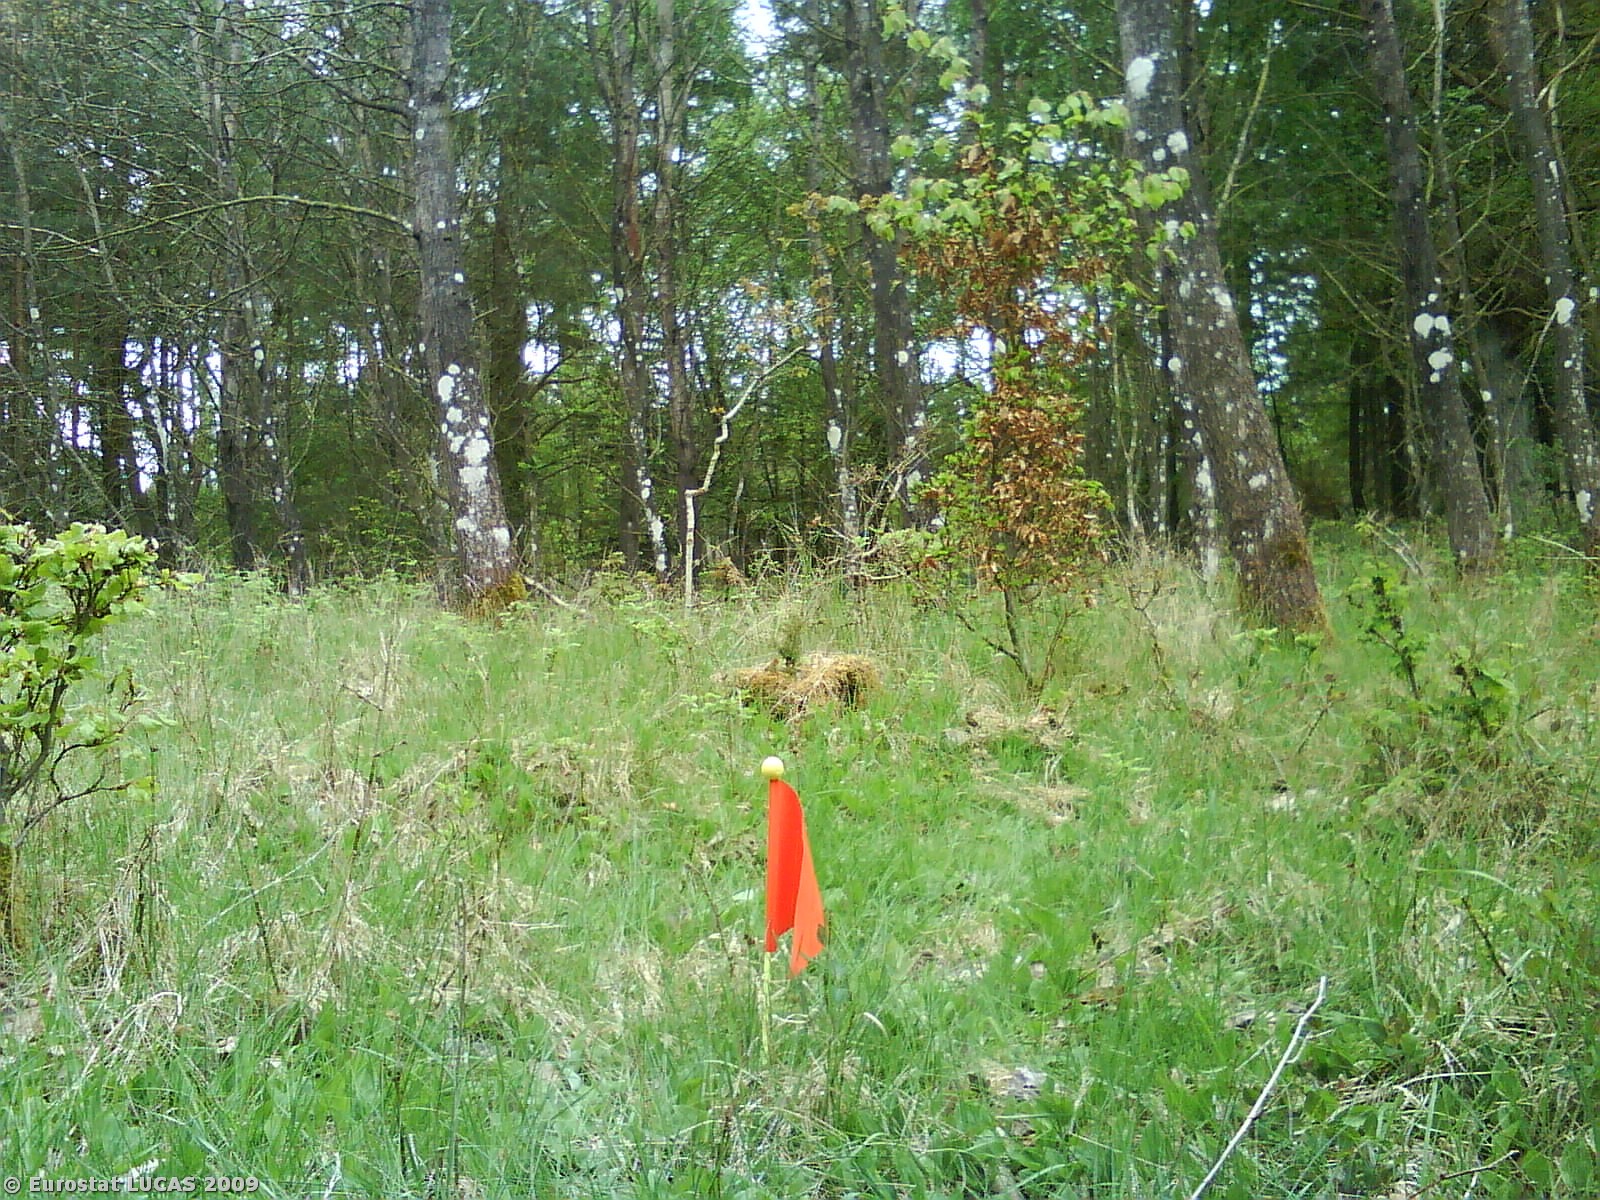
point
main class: Woodland
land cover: Mixed woodland
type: hemiboreal forest and nemoral coniferous forest and mixed broadleaved-coniferous forest
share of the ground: 10 - 25 %
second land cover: Grassland with sparse tree/shrub cover
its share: > 75 %
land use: Forestry
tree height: > 5 m
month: May
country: DK
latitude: 56.4913
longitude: 10.7299
